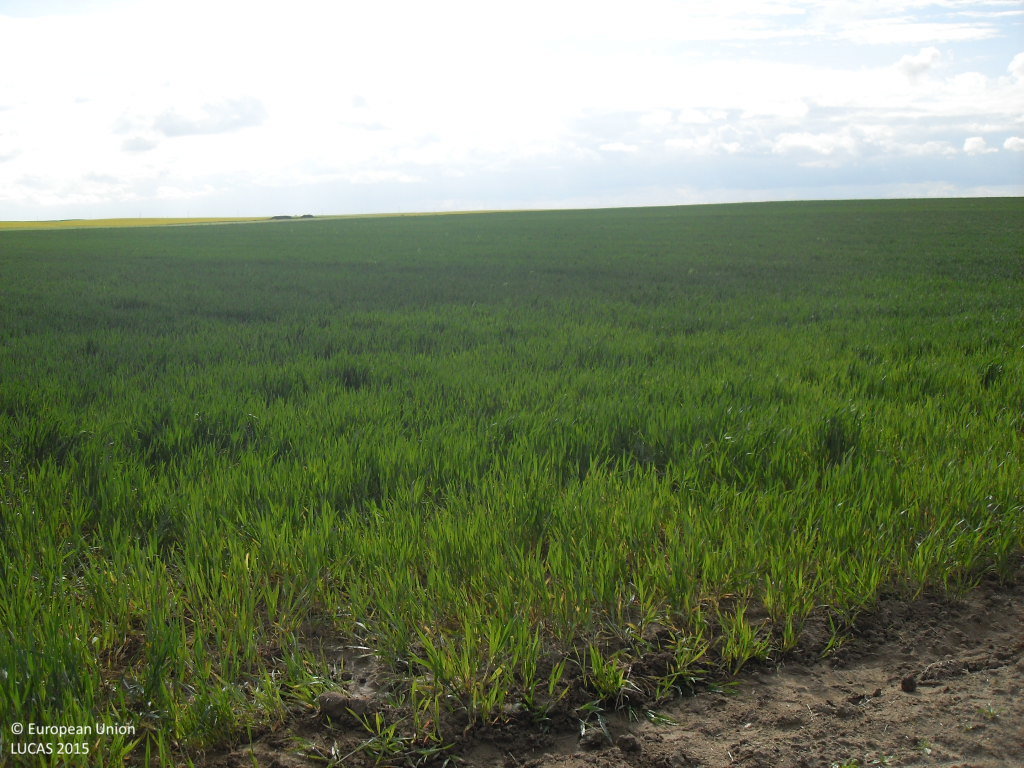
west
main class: Cropland
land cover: Sugar beet
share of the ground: > 75 %
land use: Agriculture (excluding fallow land and kitchen gardens)
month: April
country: ES
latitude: 40.9641
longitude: -5.2184
